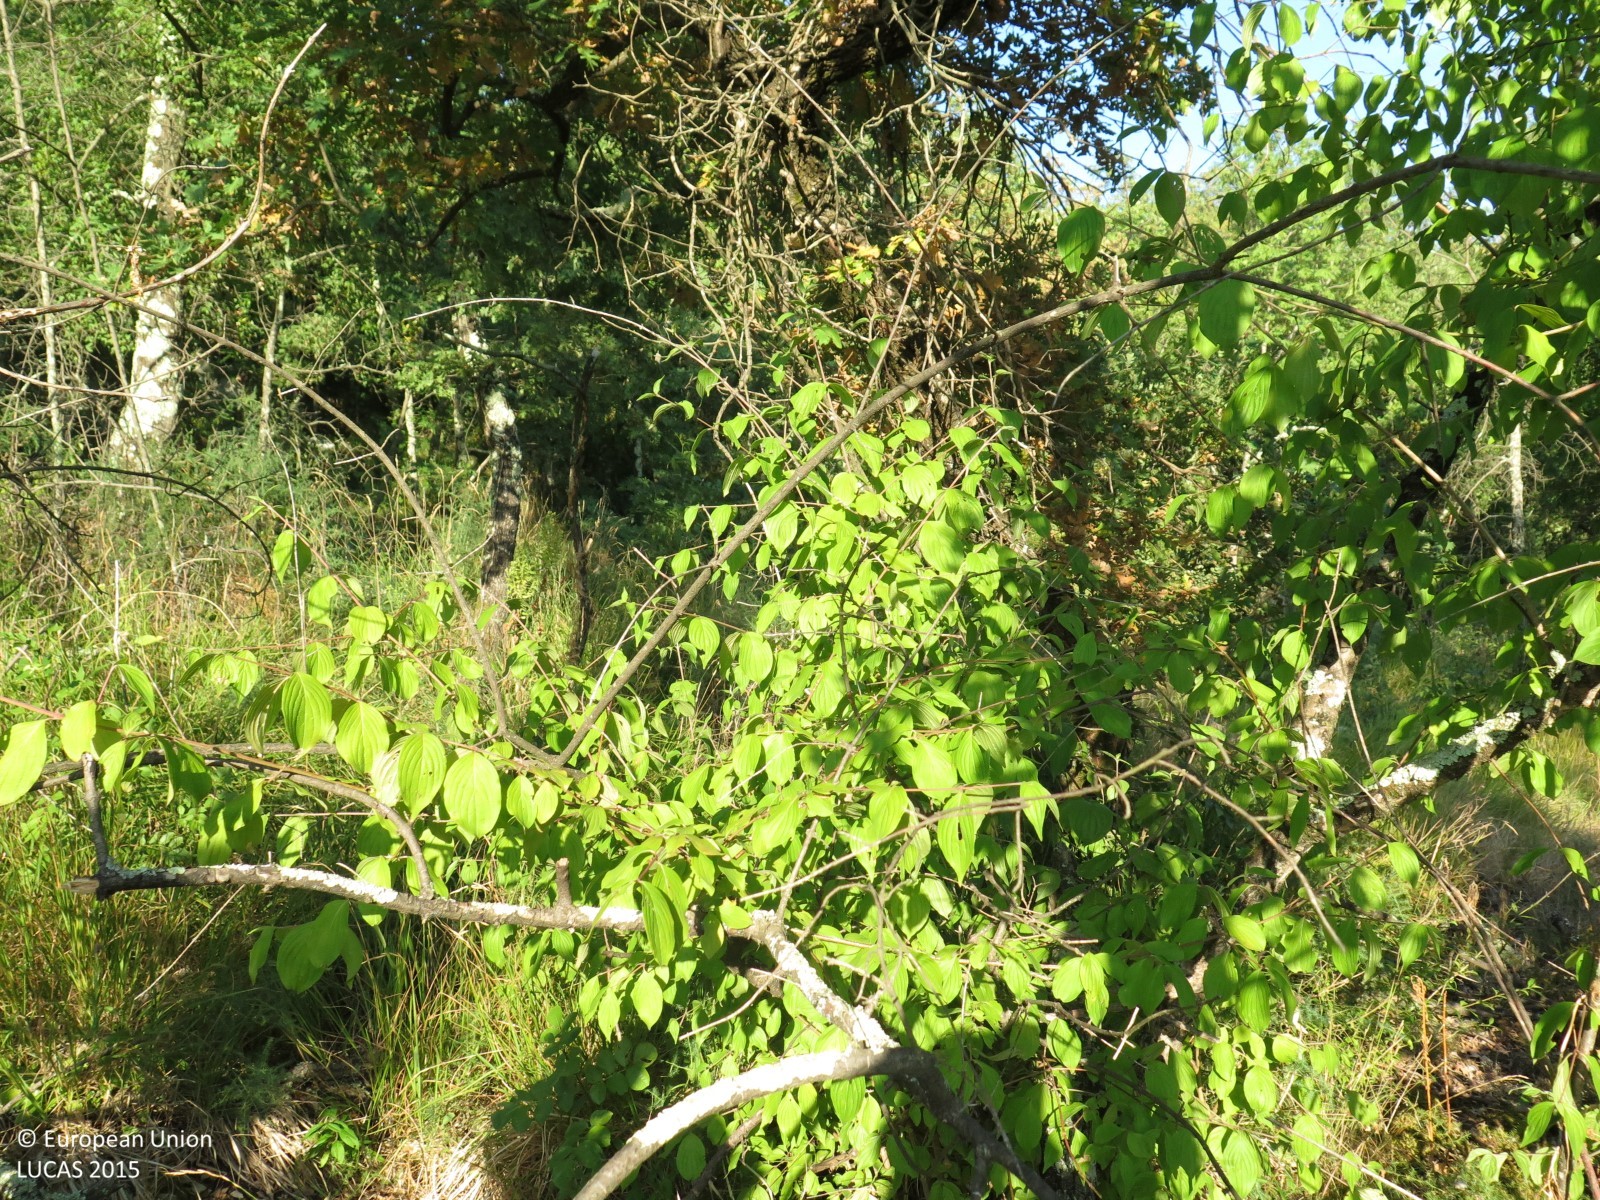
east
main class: Woodland
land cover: Broadleaved woodland
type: acidophilous oak and oak-birch forest
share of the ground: > 75 %
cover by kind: broadleaved forest trees 90 %, herbaceous plants 10 %
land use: Semi-natural and natural areas not in use
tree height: > 5 m
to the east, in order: Broadleaved woodland; Shrubland with sparse tree cover; Rocks and stones; Broadleaved woodland; Tracks; Broadleaved woodland; Rocks and stones; Broadleaved woodland; Rocks and stones; Broadleaved woodland
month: July
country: HR
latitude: 45.3539
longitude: 14.0669
